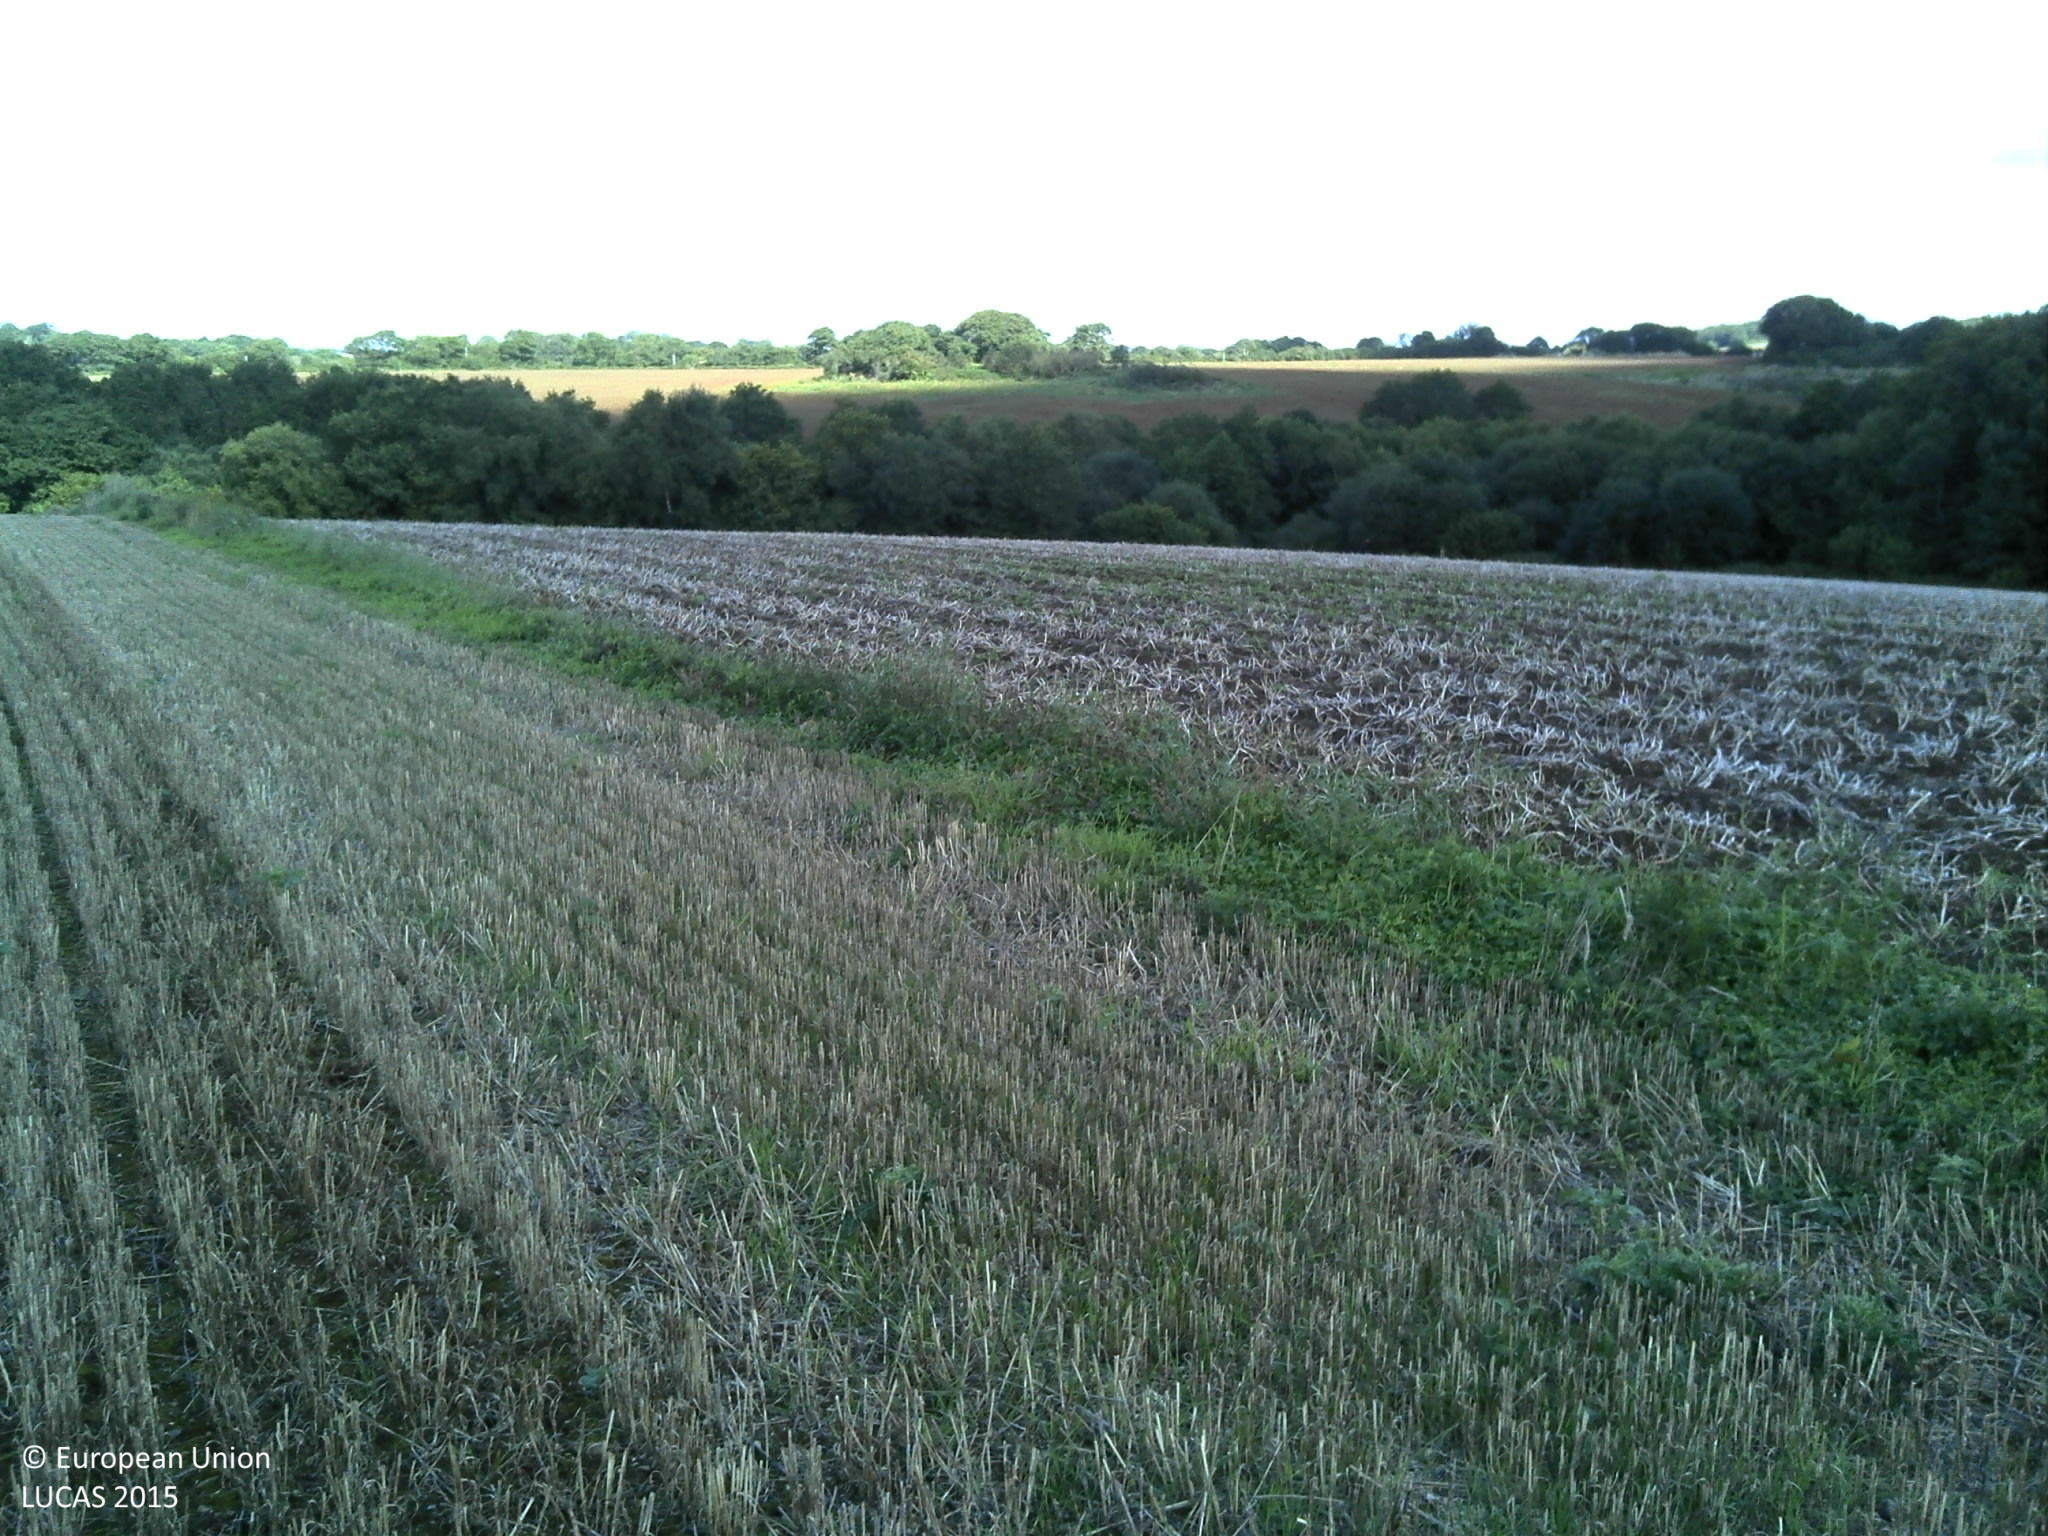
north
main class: Cropland
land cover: Durum wheat
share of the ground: > 75 %
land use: Agriculture (excluding fallow land and kitchen gardens)
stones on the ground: < 10 %
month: September
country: FR
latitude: 48.3620
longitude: -4.1690
